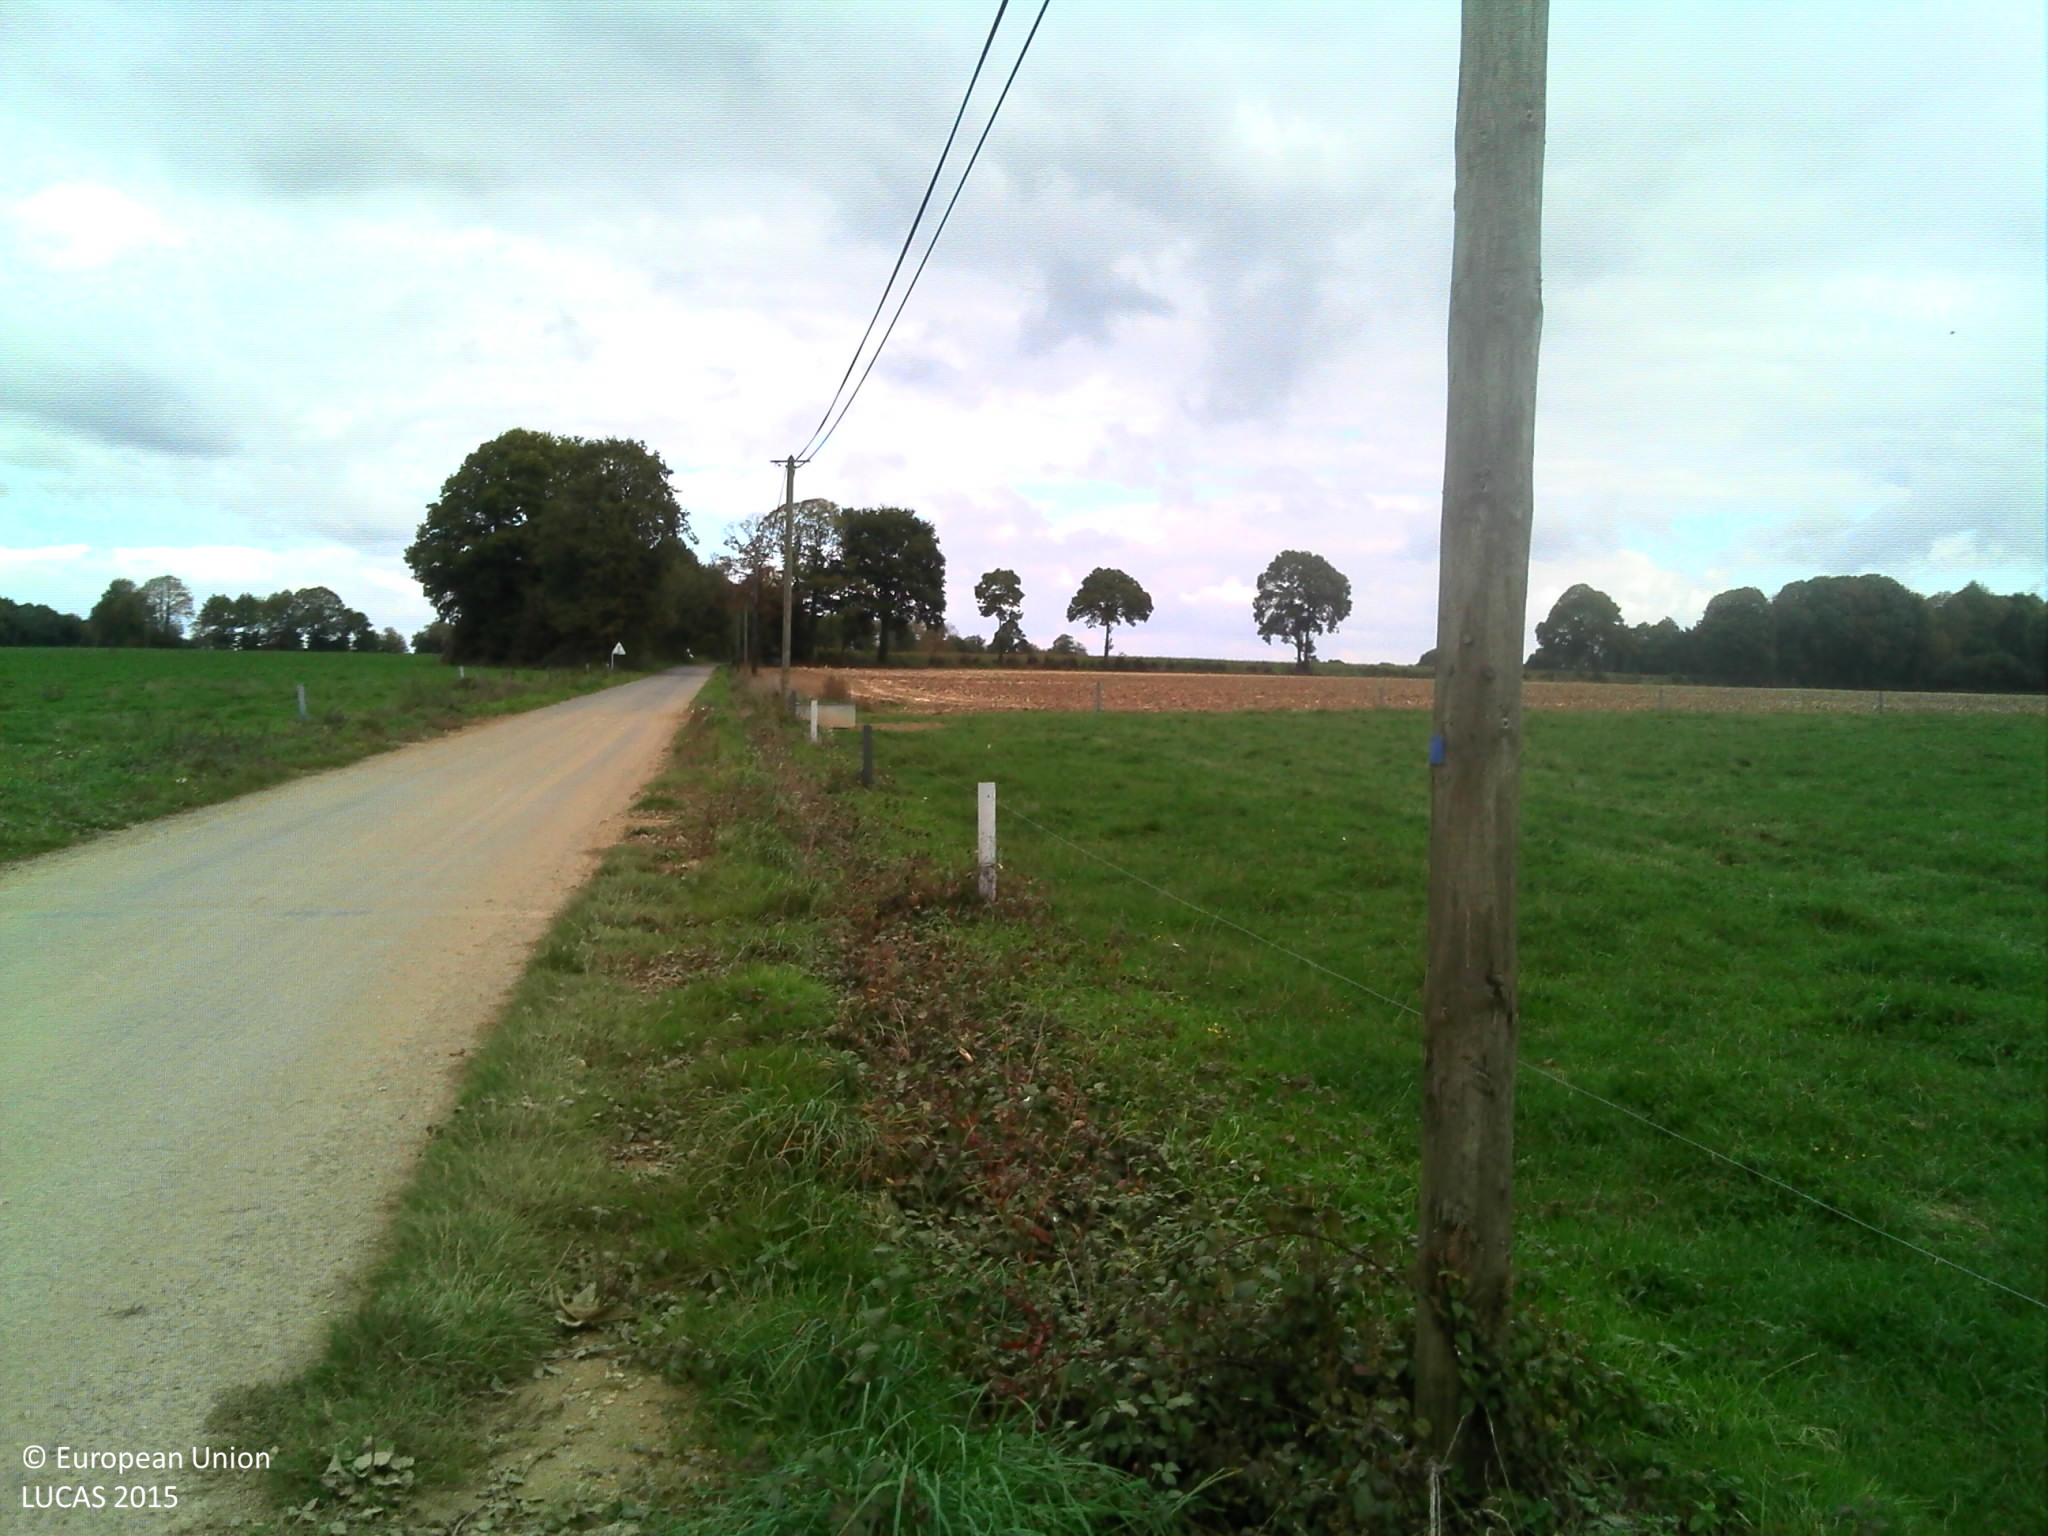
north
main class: Grassland
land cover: Grassland without tree/shrub cover
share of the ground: > 75 %
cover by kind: herbaceous plants 100 %
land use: Agriculture (excluding fallow land and kitchen gardens)
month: October
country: FR
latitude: 48.1028
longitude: -2.3999
